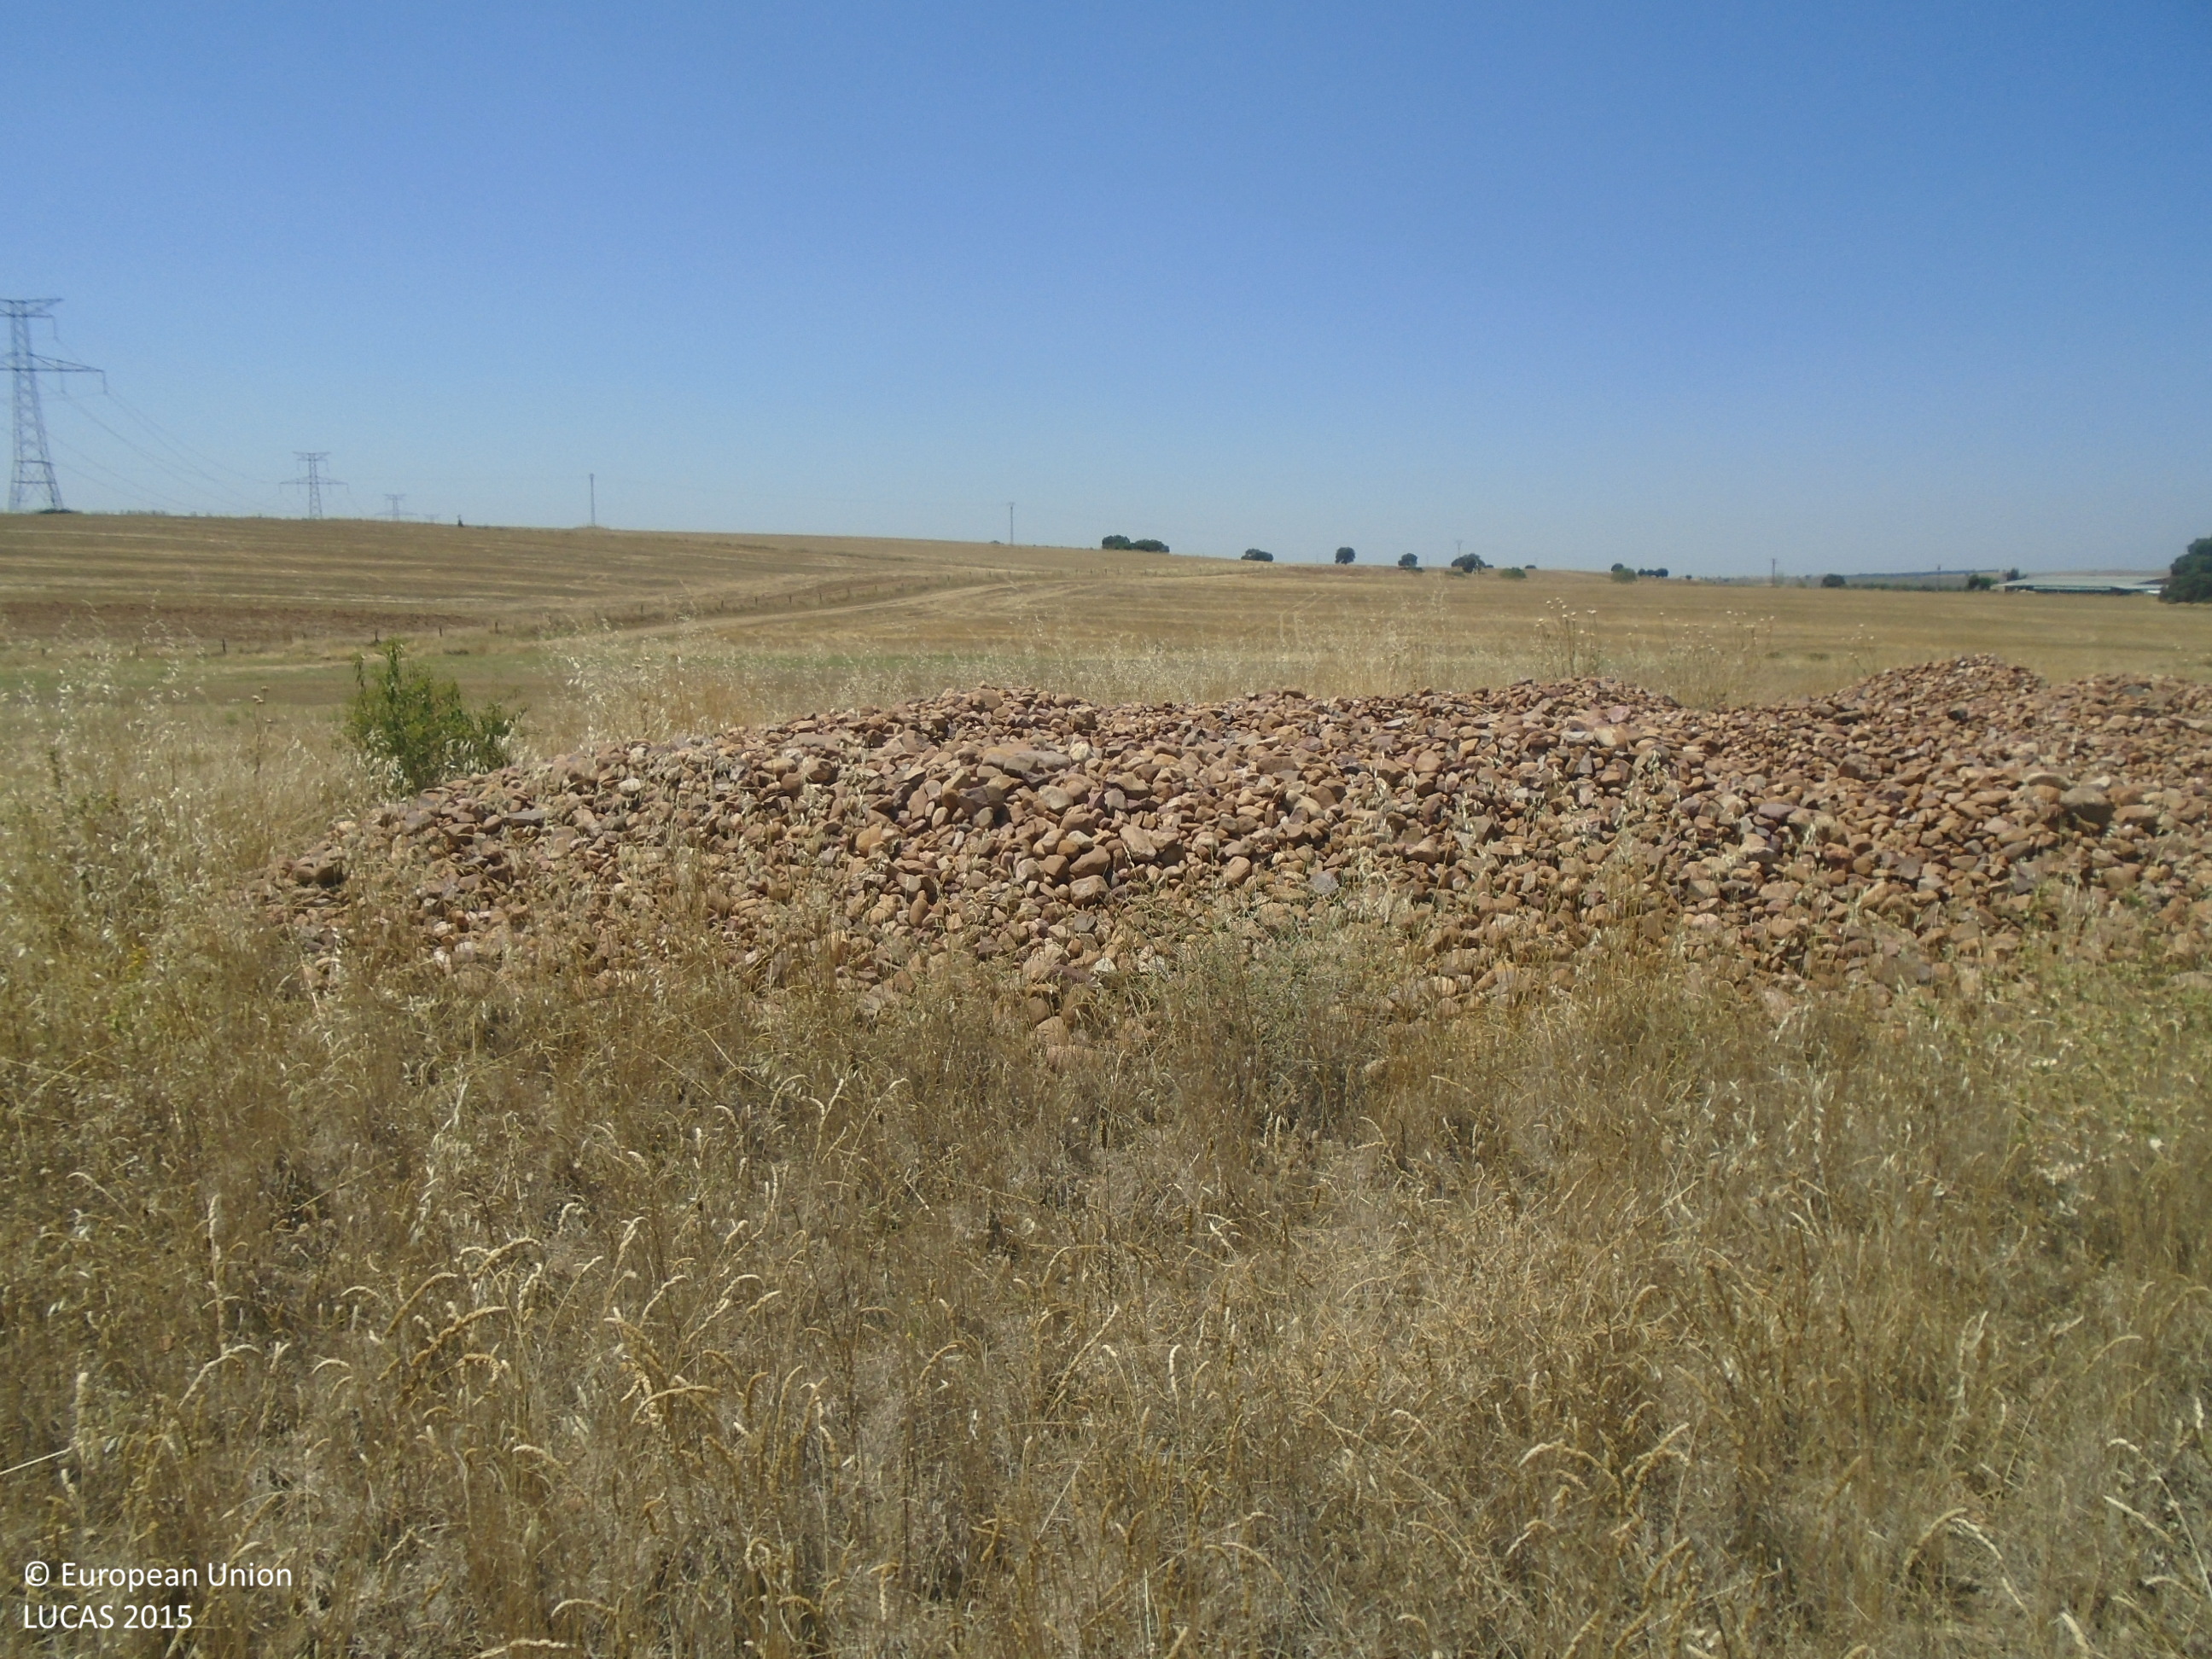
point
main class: Cropland
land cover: Barley
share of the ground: > 75 %
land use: Agriculture (excluding fallow land and kitchen gardens)
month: July
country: ES
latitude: 39.8032
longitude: -4.8915
